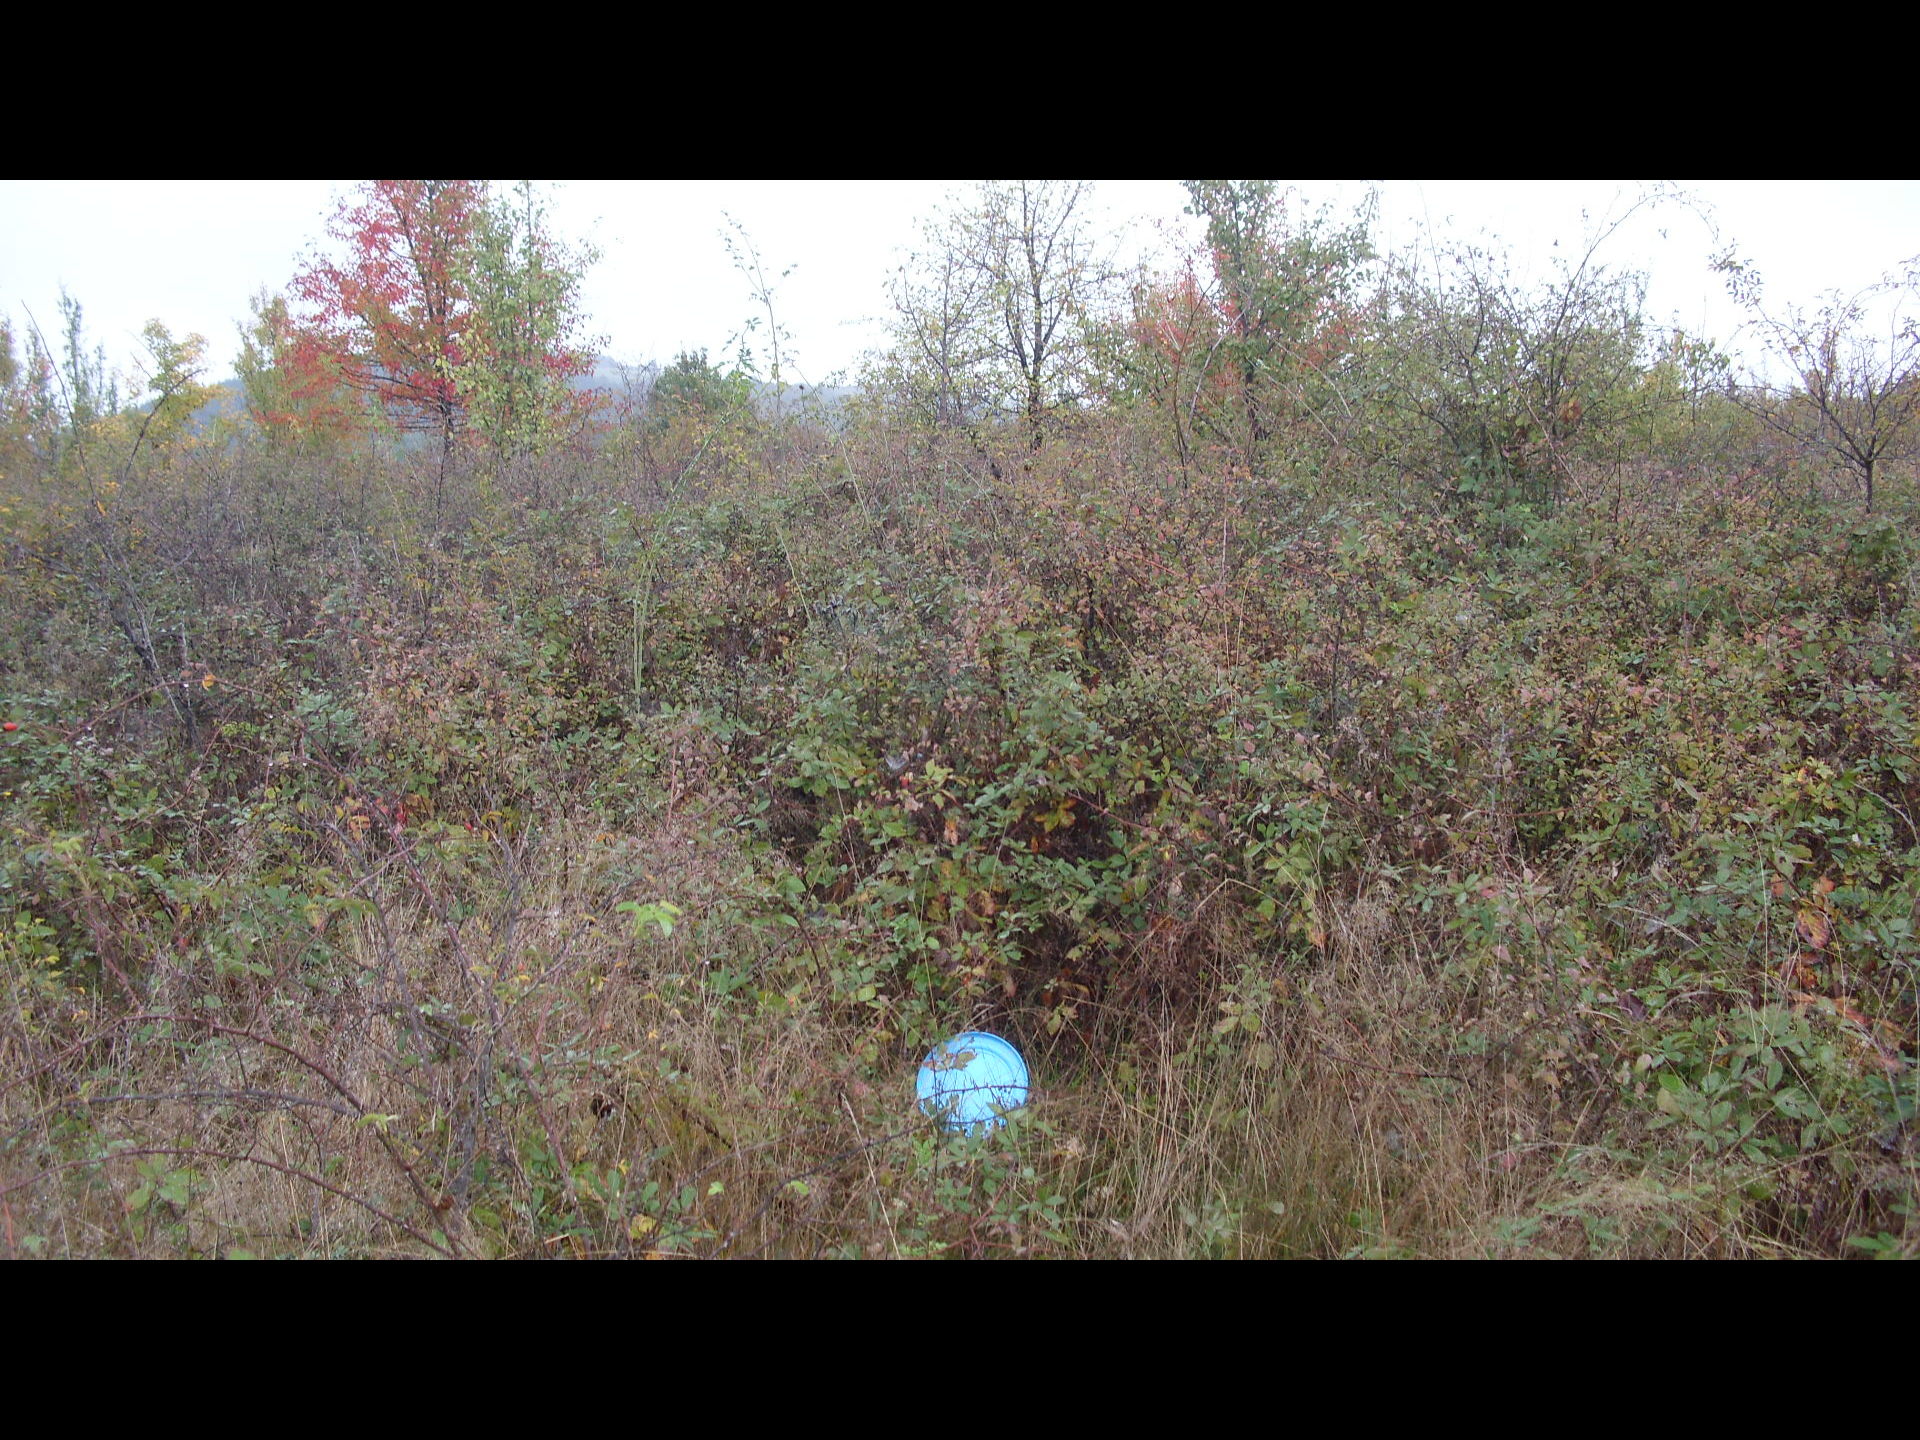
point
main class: Shrubland
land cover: Shrubland with sparse tree cover
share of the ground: > 75 %
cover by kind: shrubs 90 %, broadleaved forest trees 5 %, herbaceous plants 5 %
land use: Semi-natural and natural areas not in use
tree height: < 5 m
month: October
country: BG
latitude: 43.5429
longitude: 22.7444
